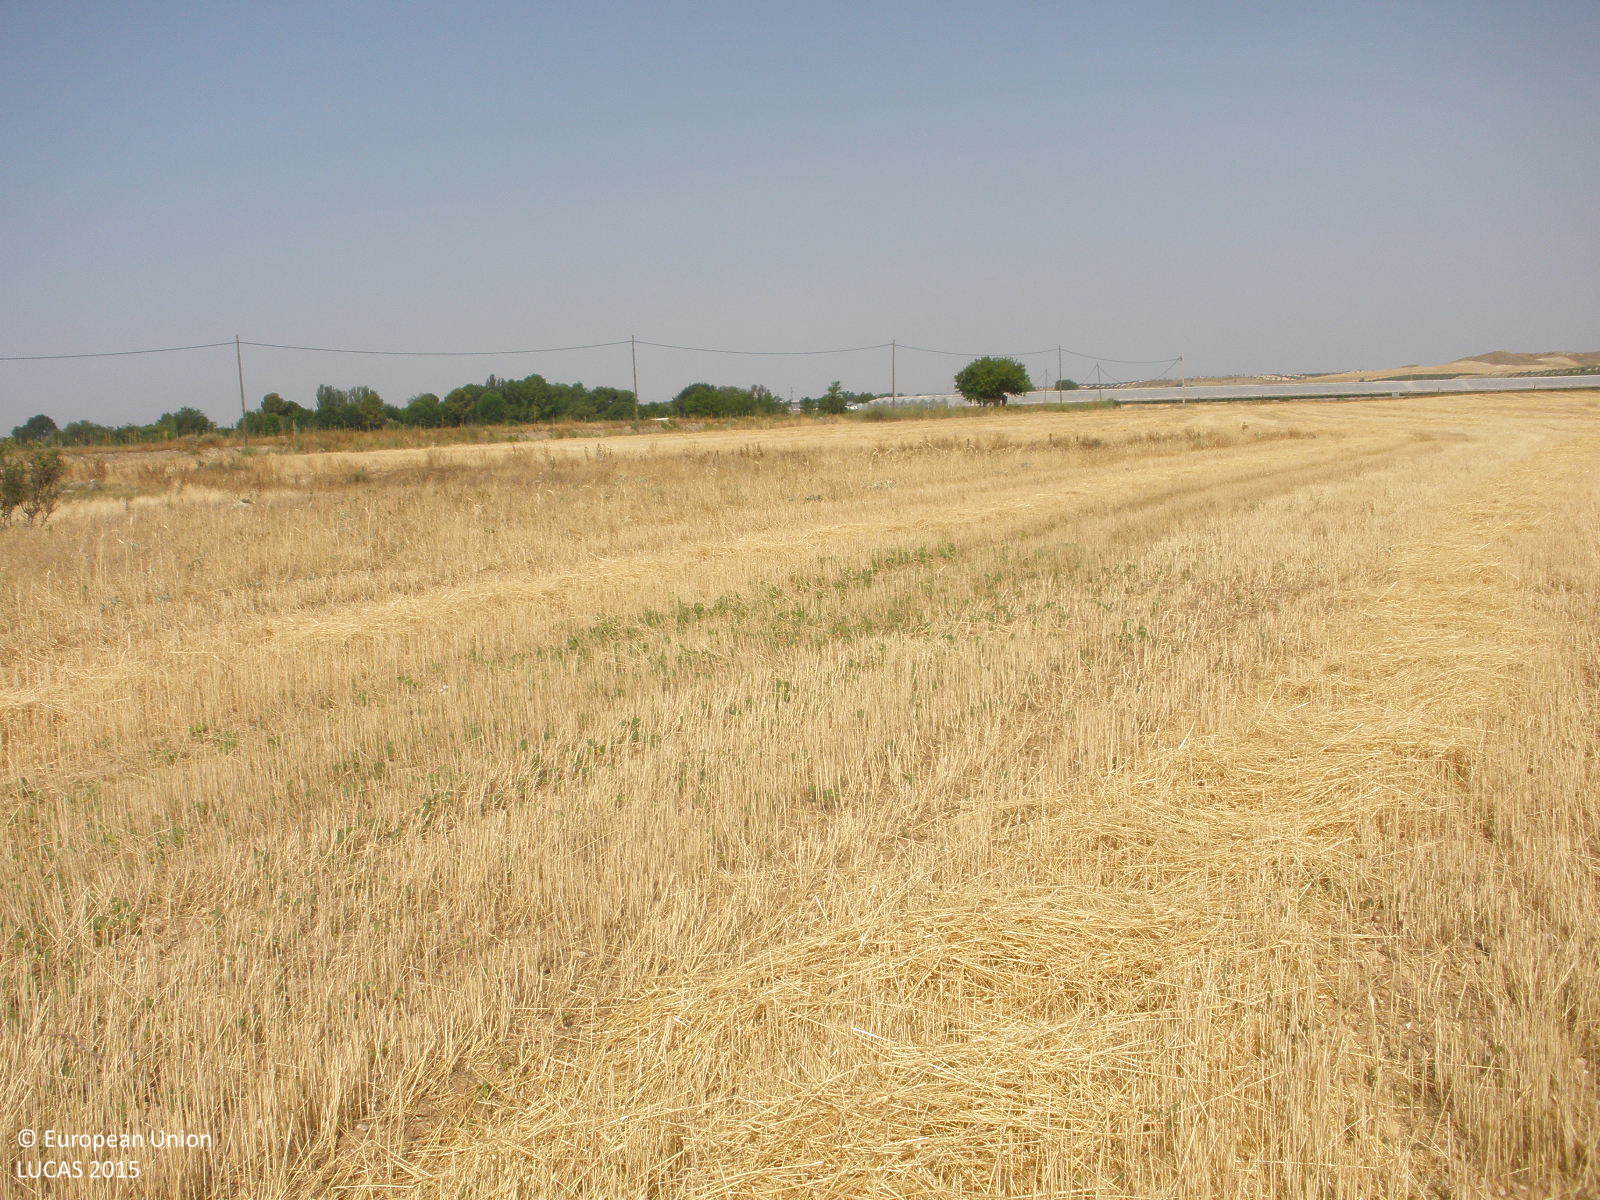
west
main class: Cropland
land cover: Barley
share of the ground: < 10 %
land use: Agriculture (excluding fallow land and kitchen gardens)
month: July
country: ES
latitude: 40.0620
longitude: -3.5010
